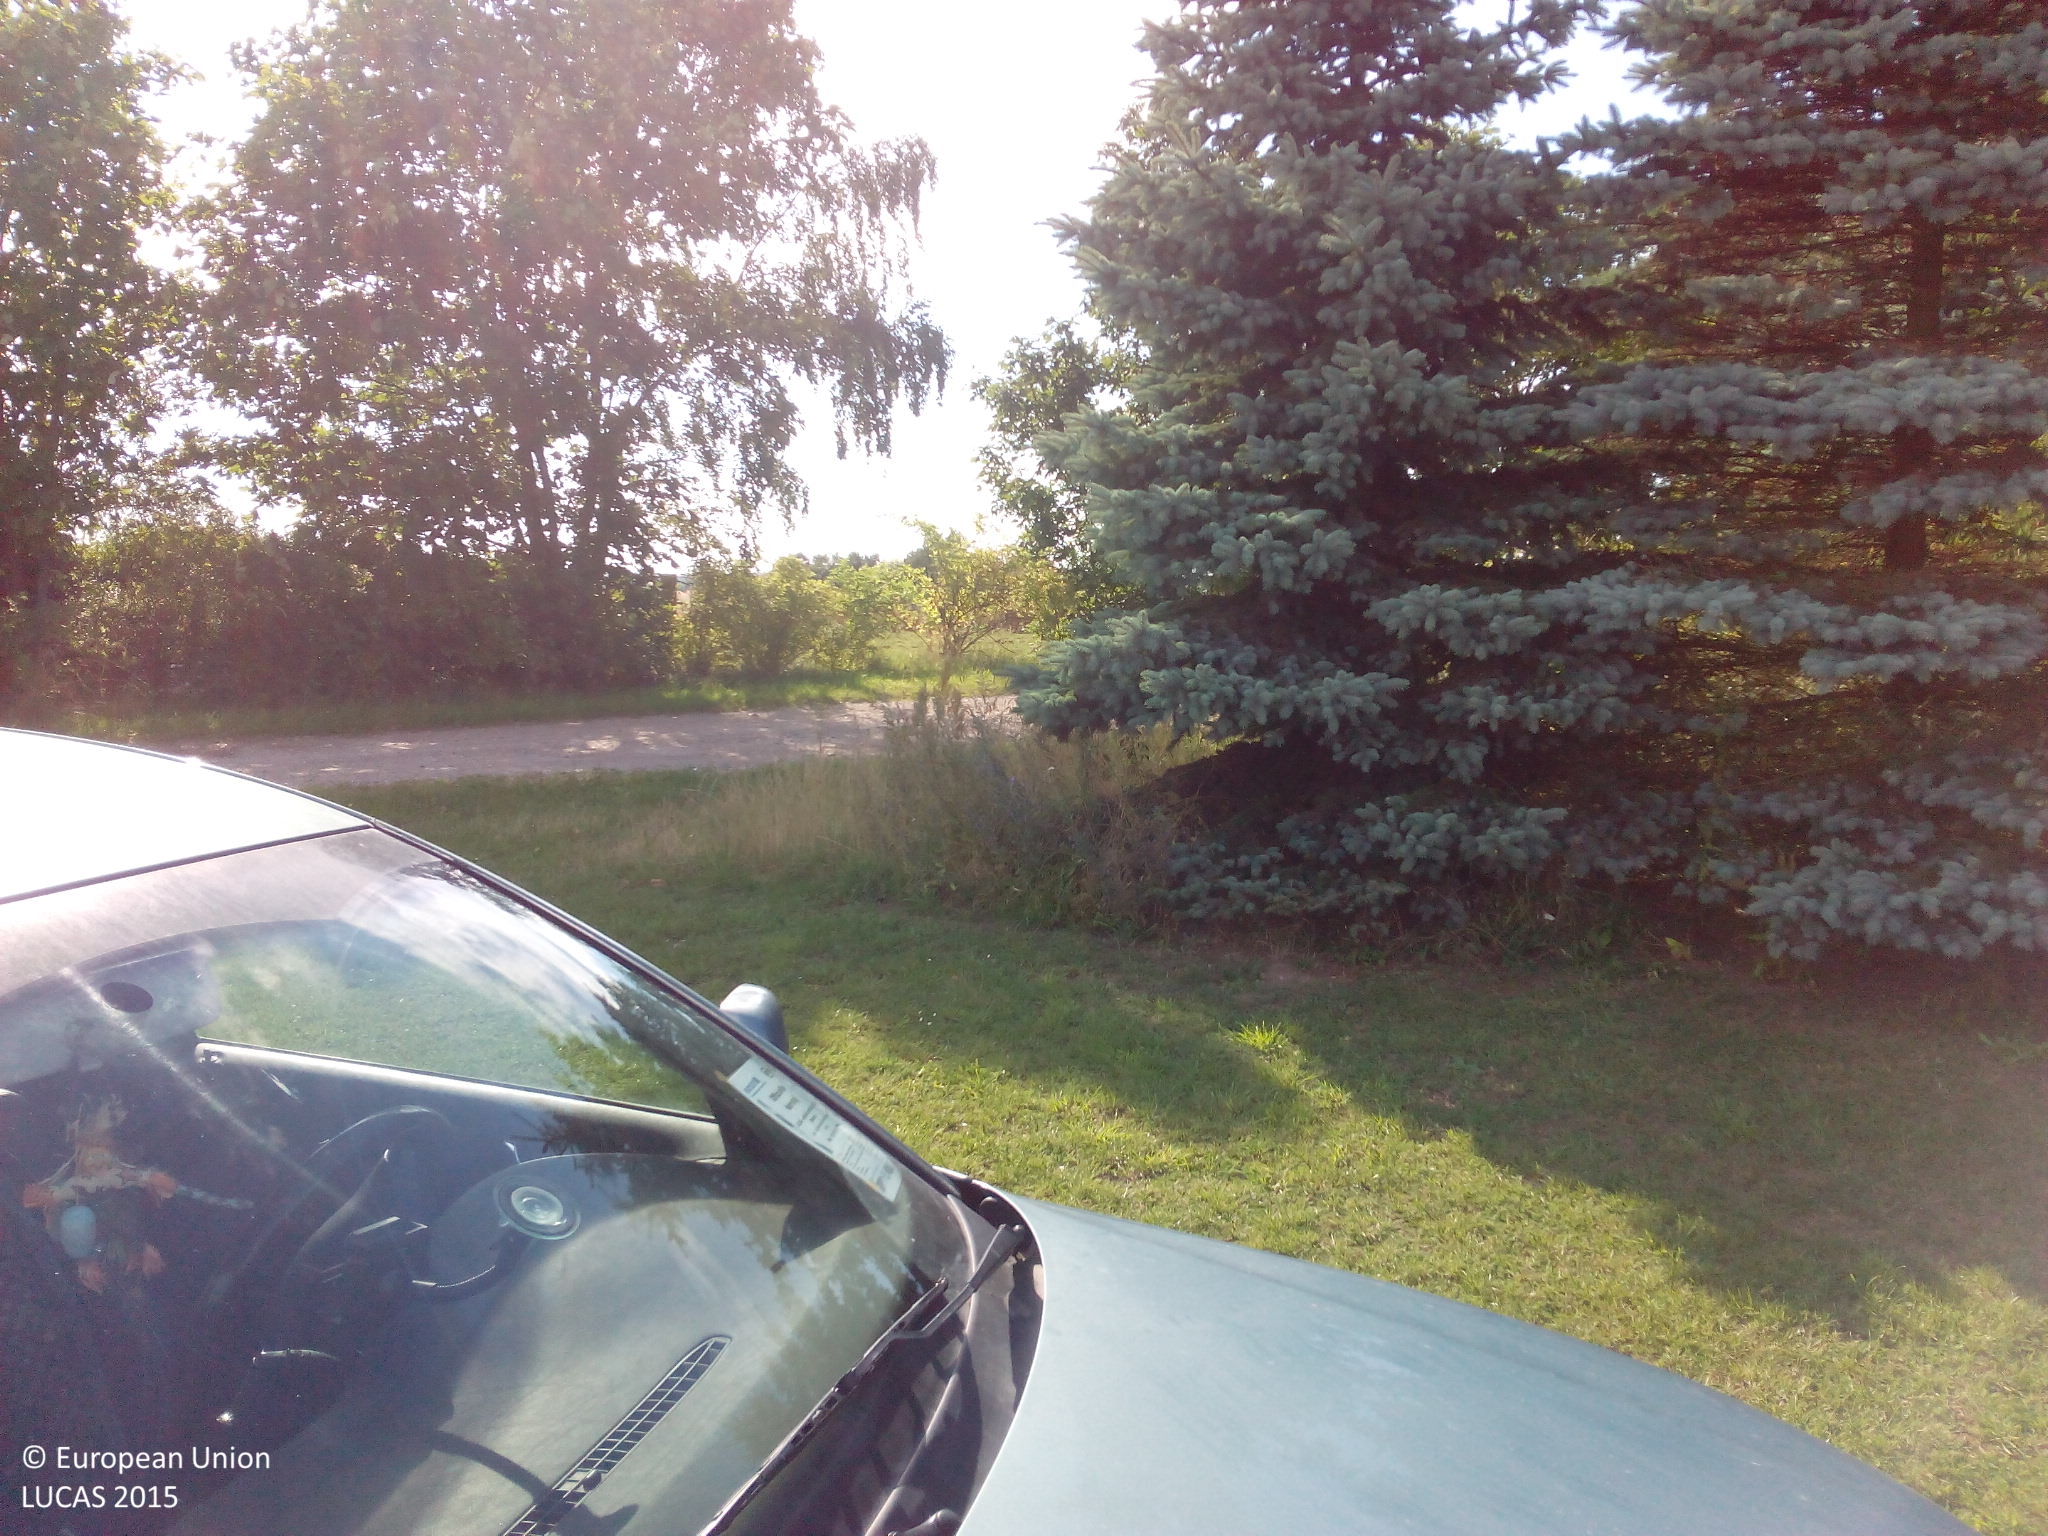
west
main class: Cropland
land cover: Barley
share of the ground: > 75 %
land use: Agriculture (excluding fallow land and kitchen gardens)
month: August
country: DK
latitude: 55.5657
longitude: 11.6635
